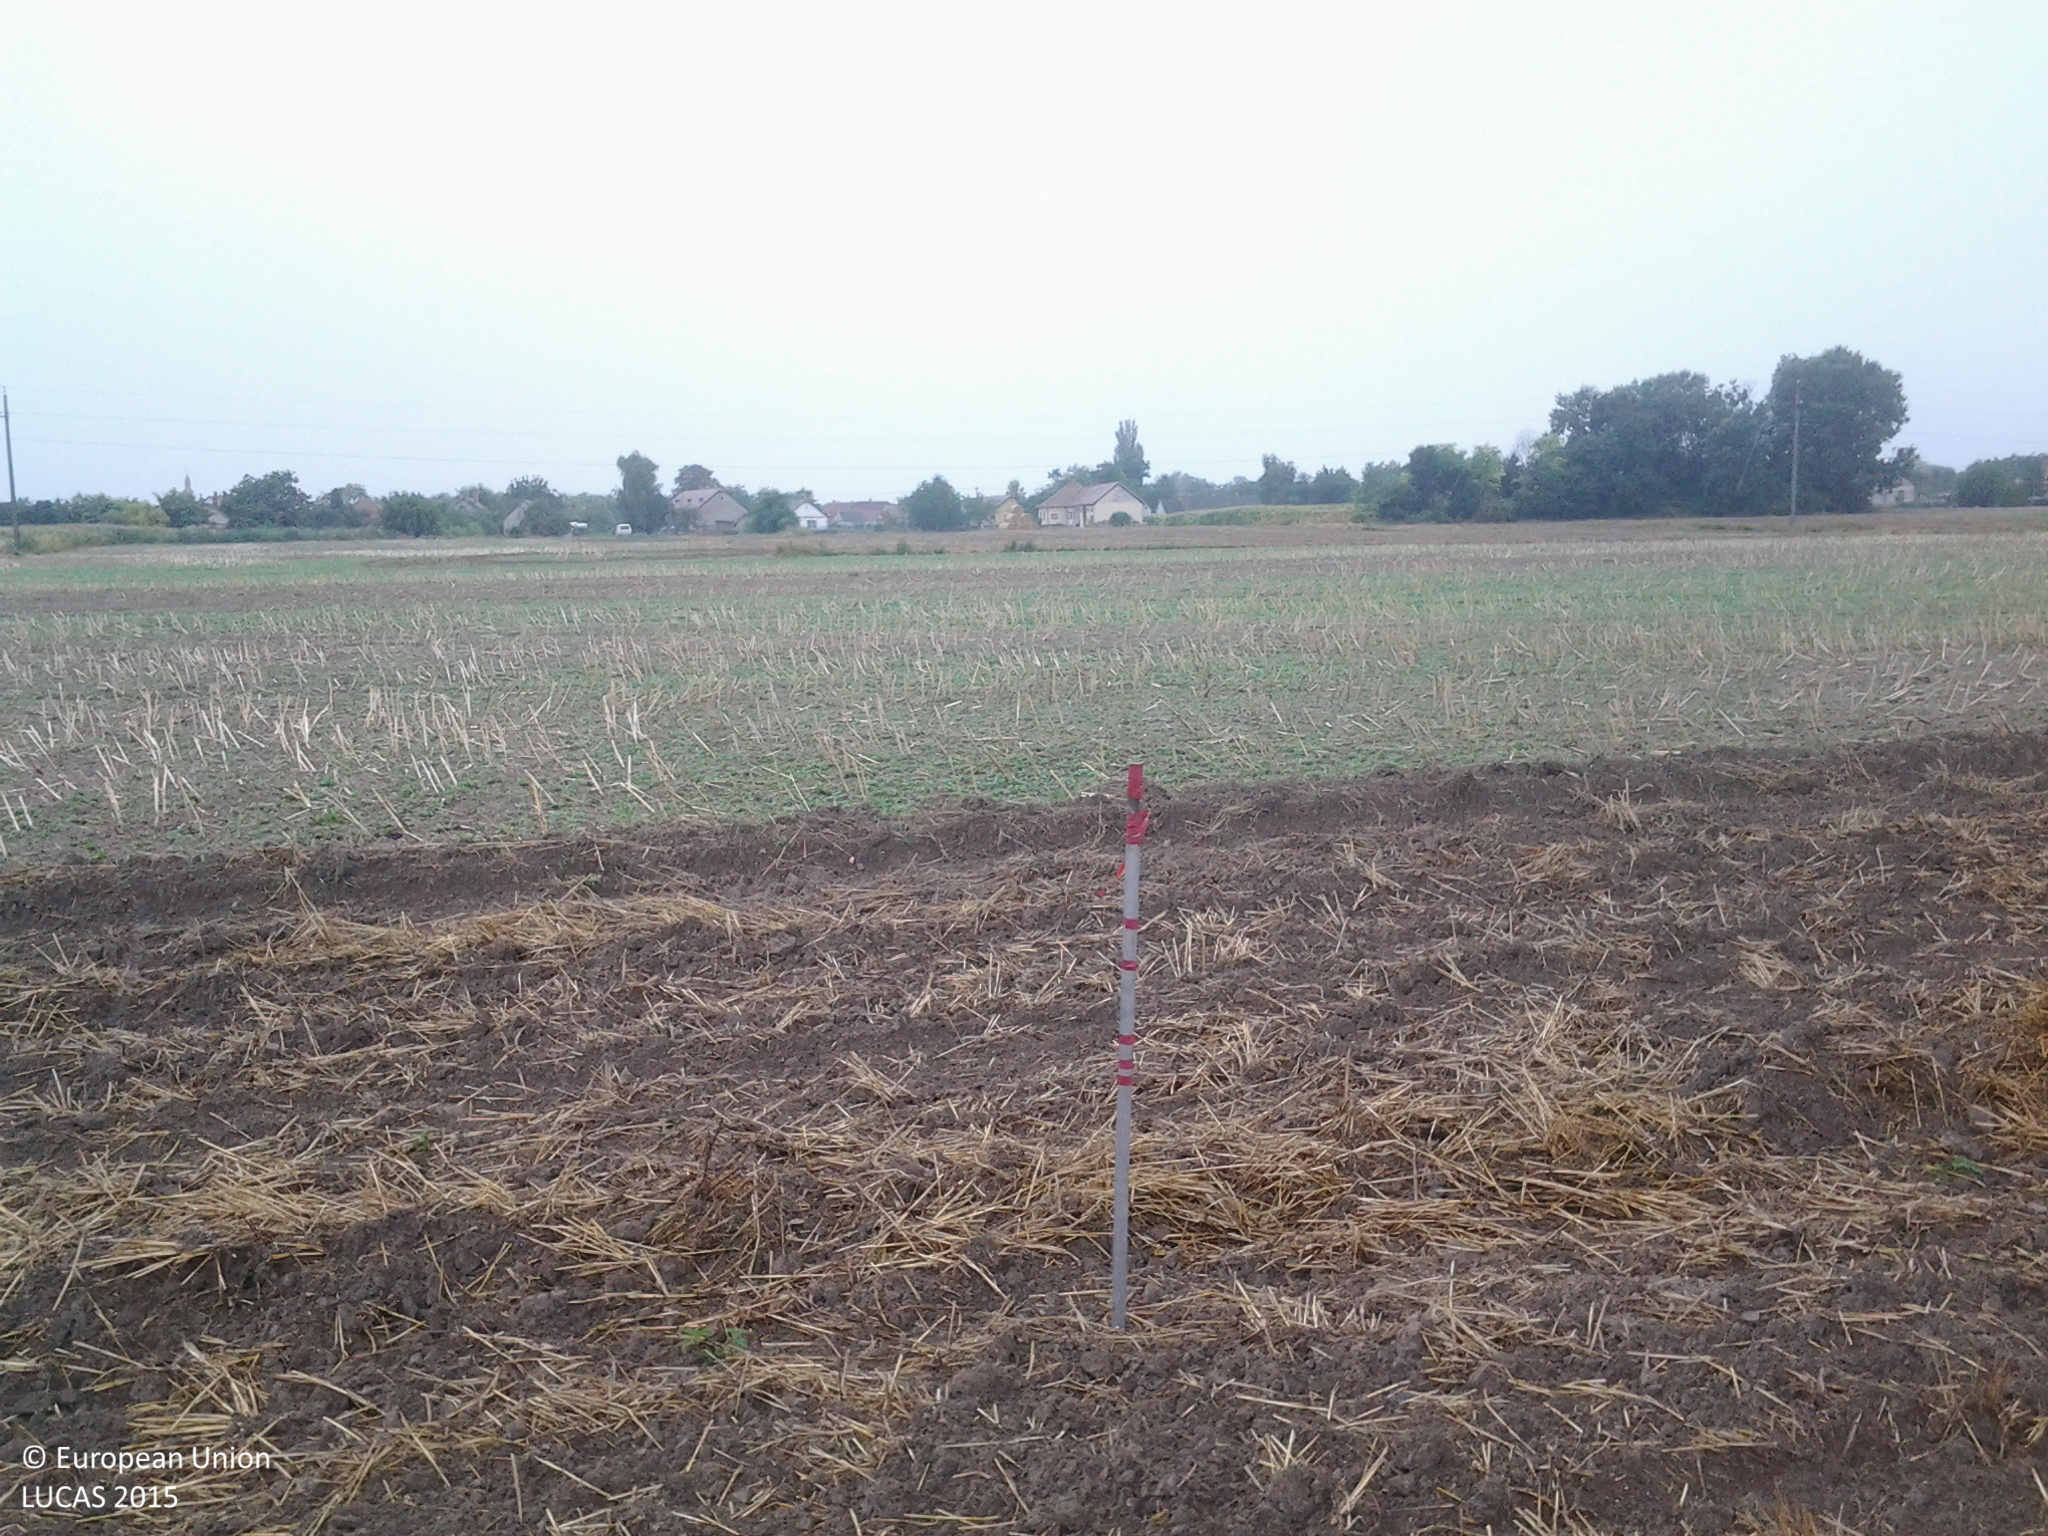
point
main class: Cropland
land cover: Common wheat
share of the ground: < 10 %
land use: Agriculture (excluding fallow land and kitchen gardens)
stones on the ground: < 10 %
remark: Harvested field
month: July
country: HU
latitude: 46.9838
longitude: 19.0215
